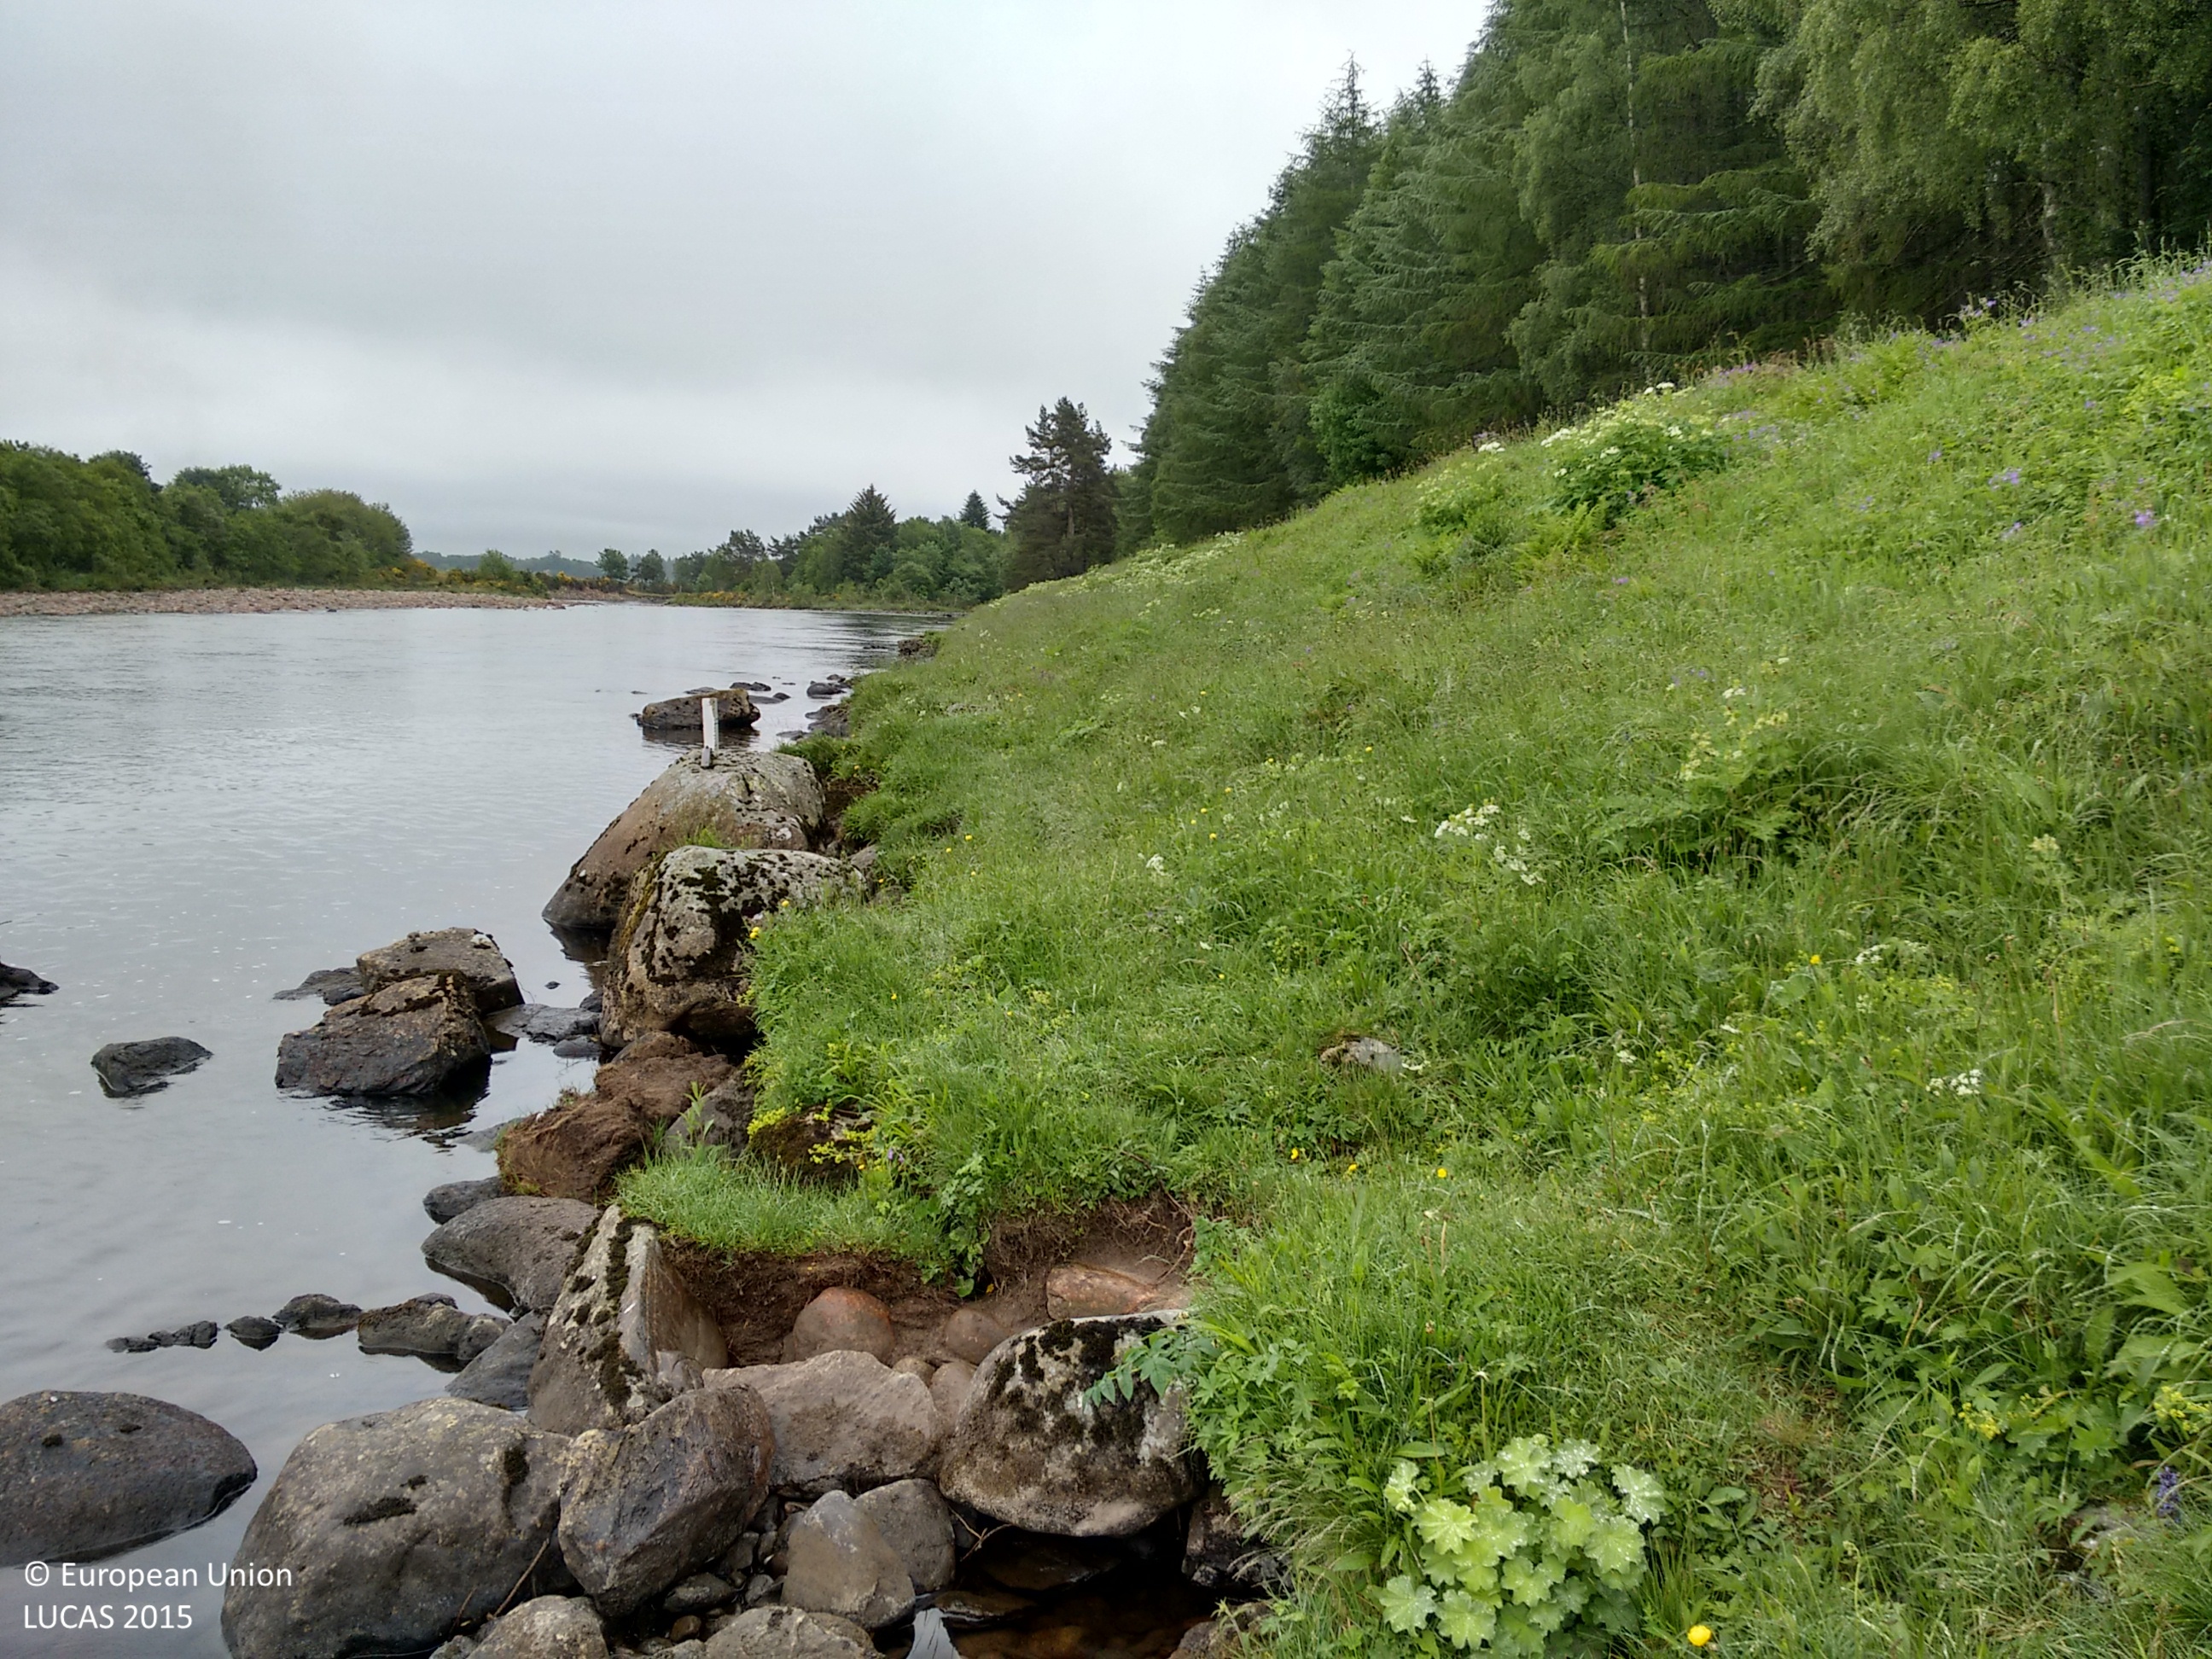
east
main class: Shrubland
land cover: Shrubland without tree cover
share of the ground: > 75 %
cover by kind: shrubs 50 %, herbaceous plants 50 %
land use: Semi-natural and natural areas not in use
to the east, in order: Shrubland without tree cover; Grassland without tree/shrub cover; Inland fresh running water; Rocks and stones
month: June
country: GB
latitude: 57.0708
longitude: -2.8434
